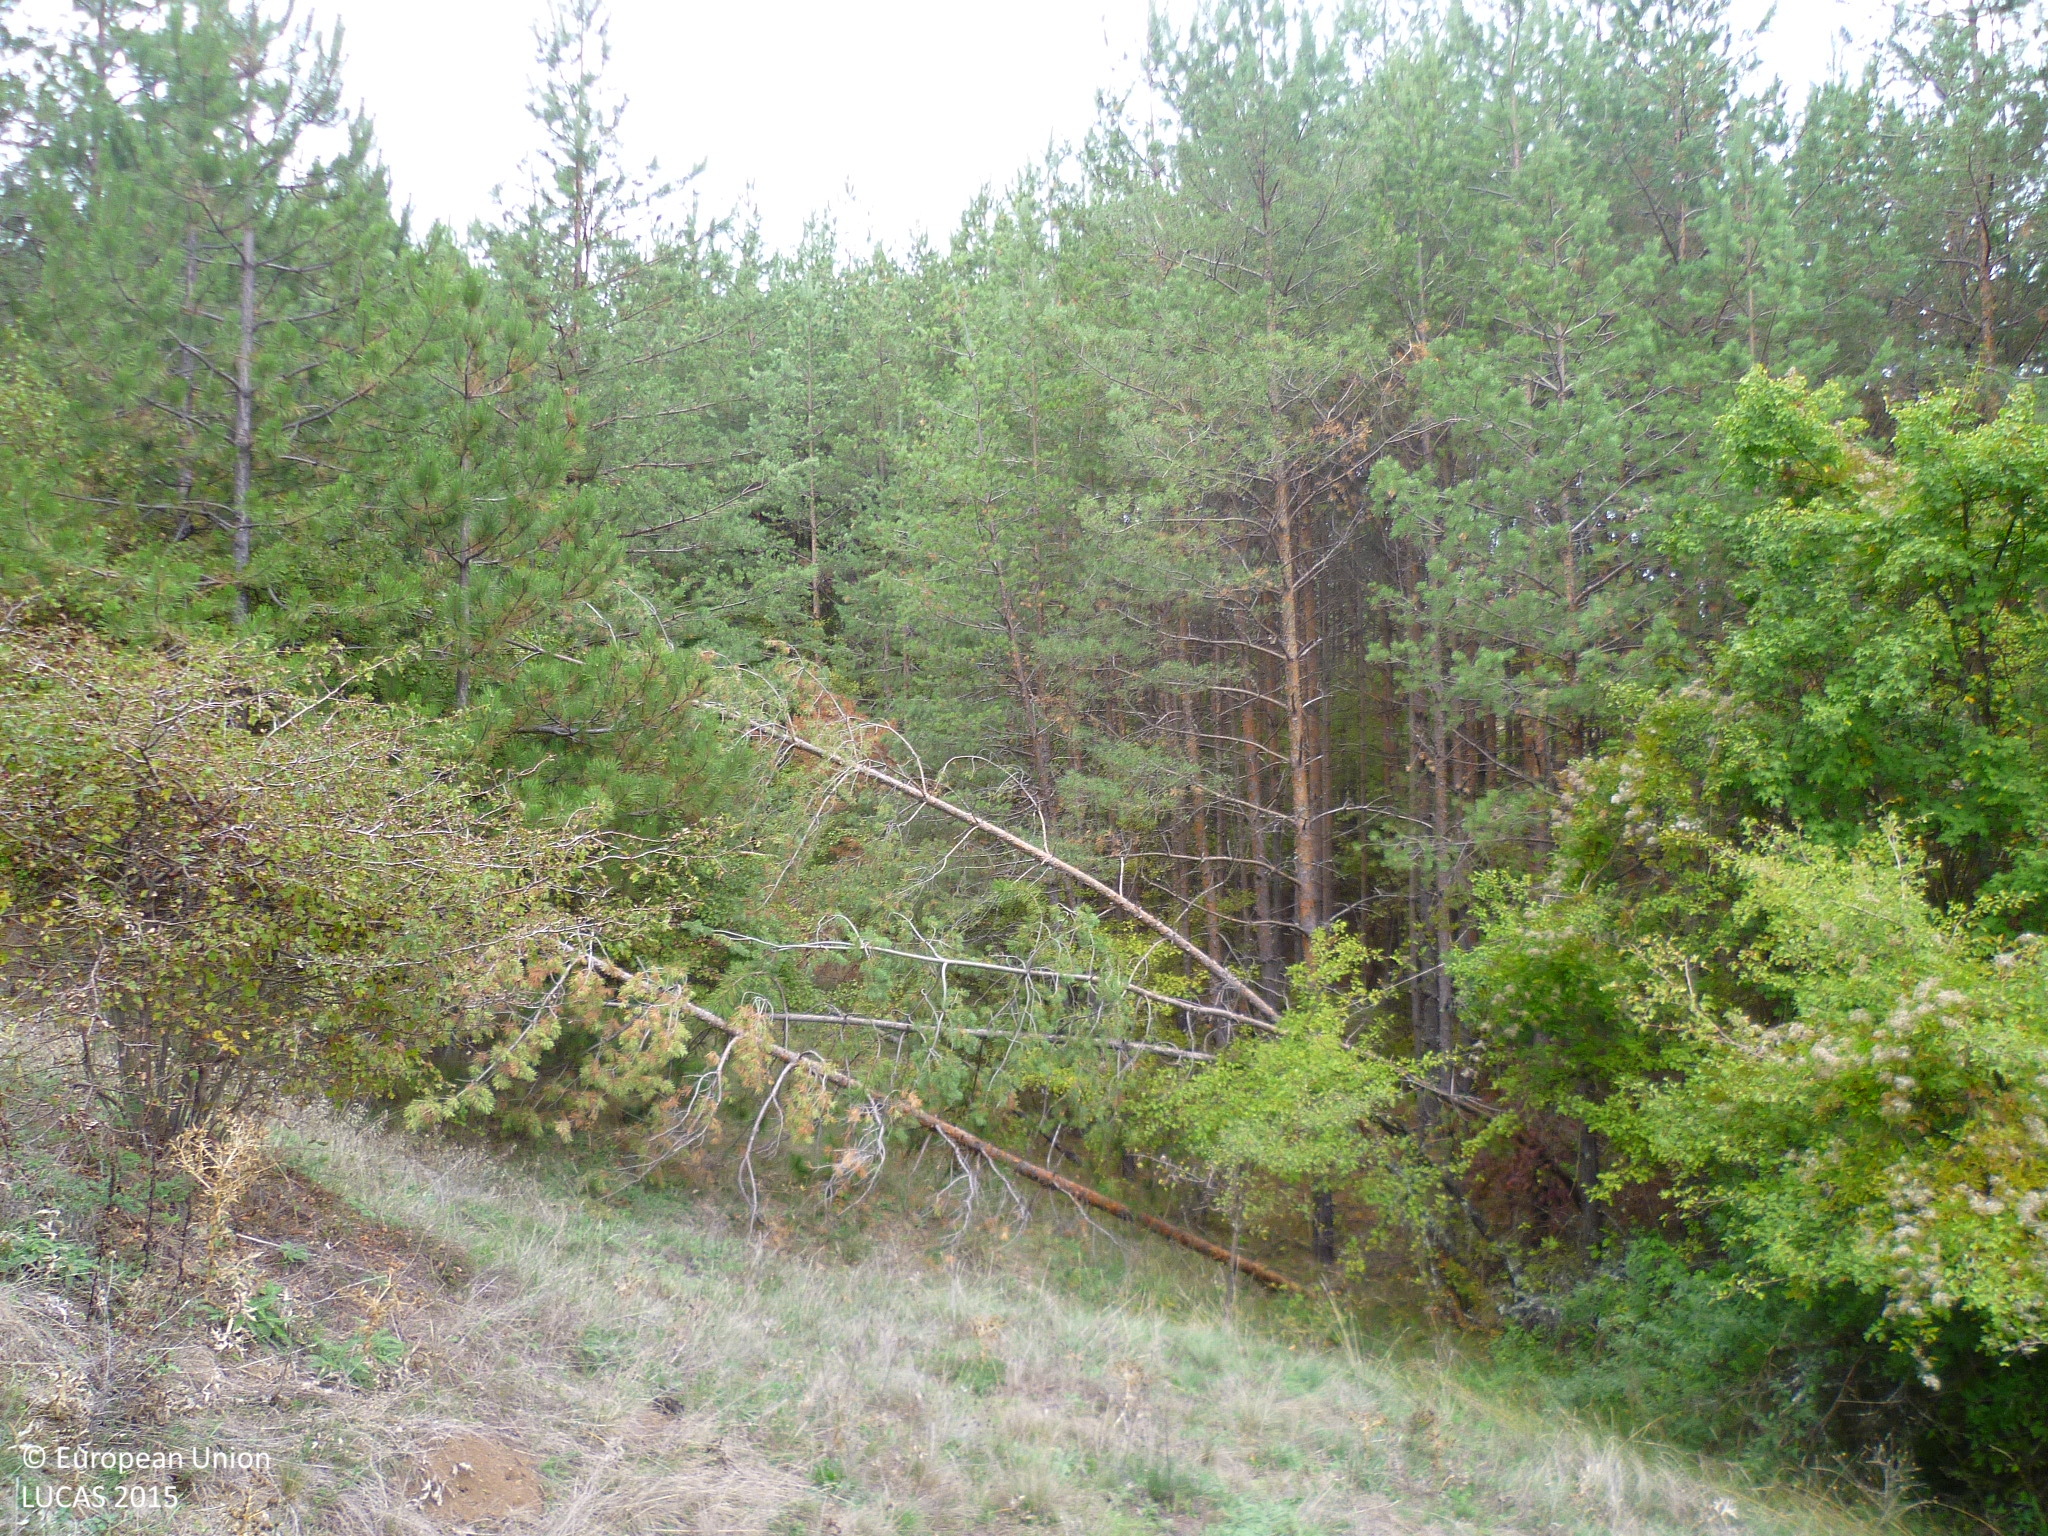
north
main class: Grassland
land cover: Grassland with sparse tree/shrub cover
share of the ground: > 75 %
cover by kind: herbaceous plants 90 %, coniferous forest trees 5 %, shrubs 5 %
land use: Agriculture (excluding fallow land and kitchen gardens)
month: October
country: BG
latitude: 42.8082
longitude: 22.7825
